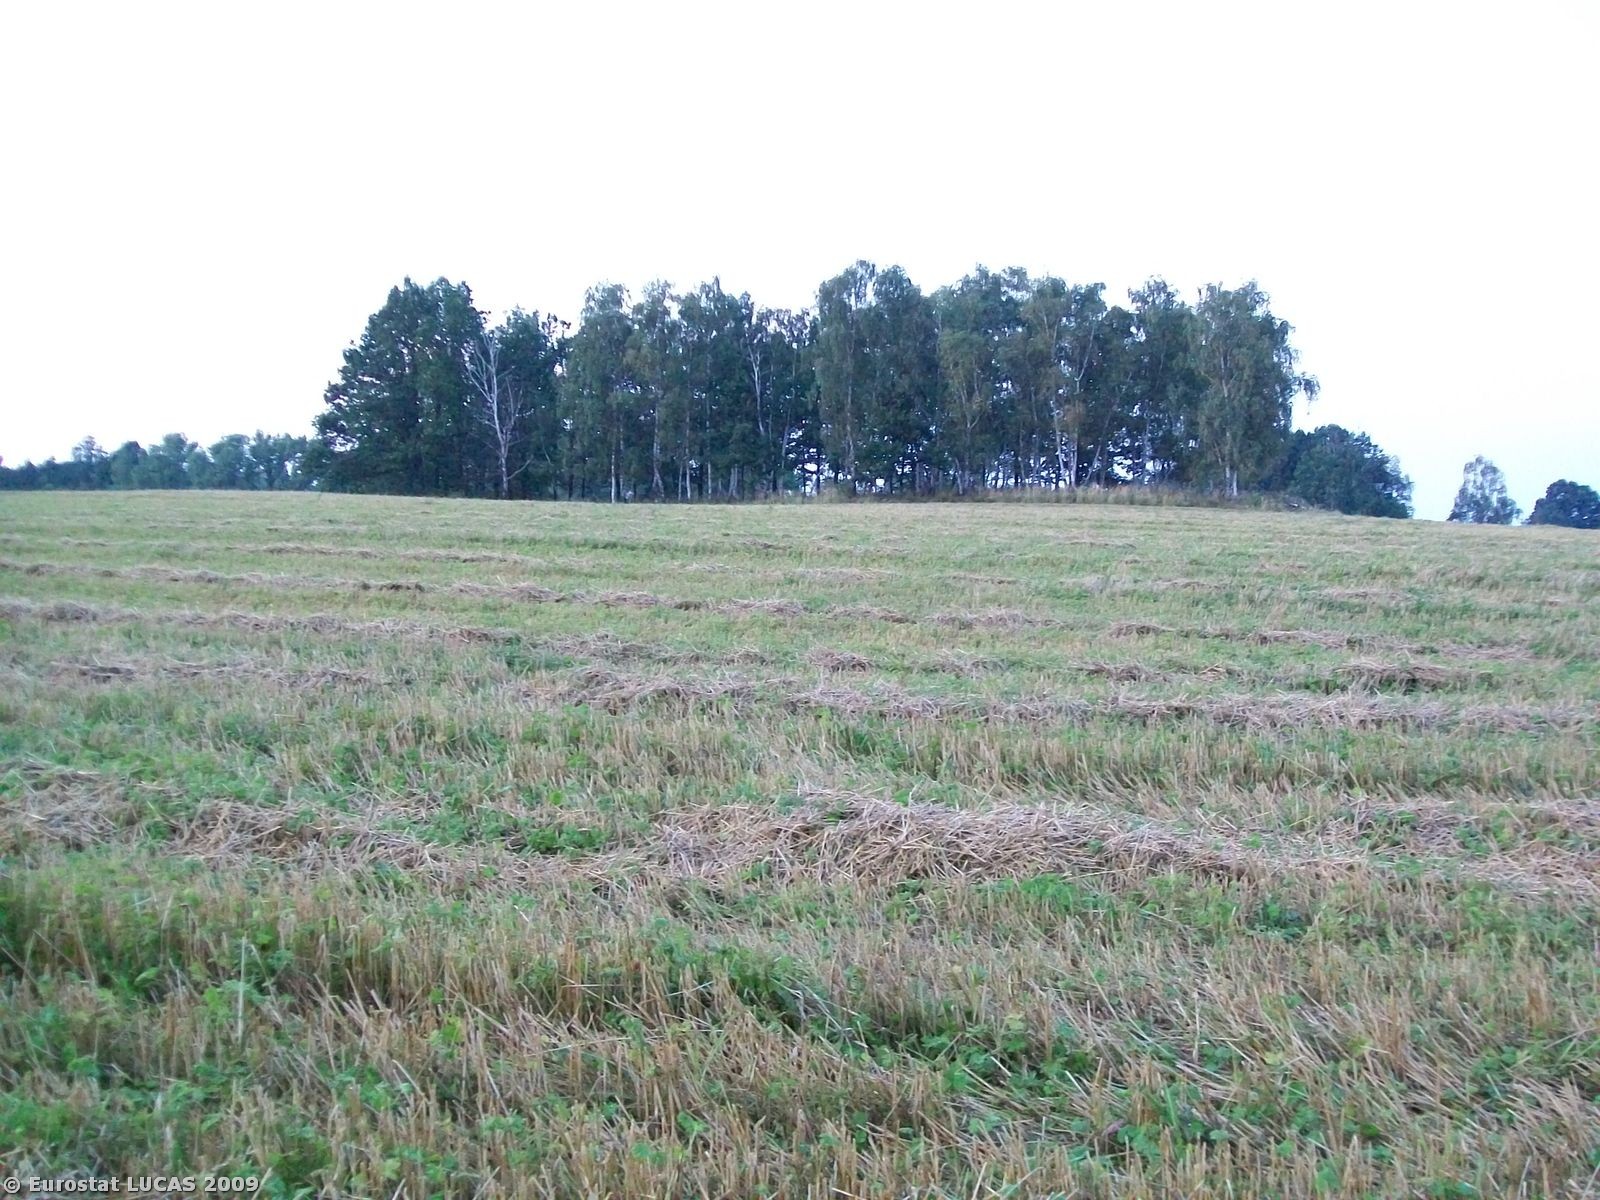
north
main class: Cropland
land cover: Common wheat
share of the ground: < 10 %
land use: Agriculture (excluding fallow land and kitchen gardens)
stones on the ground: < 10 %
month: September
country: PL
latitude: 50.6564
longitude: 16.6709
